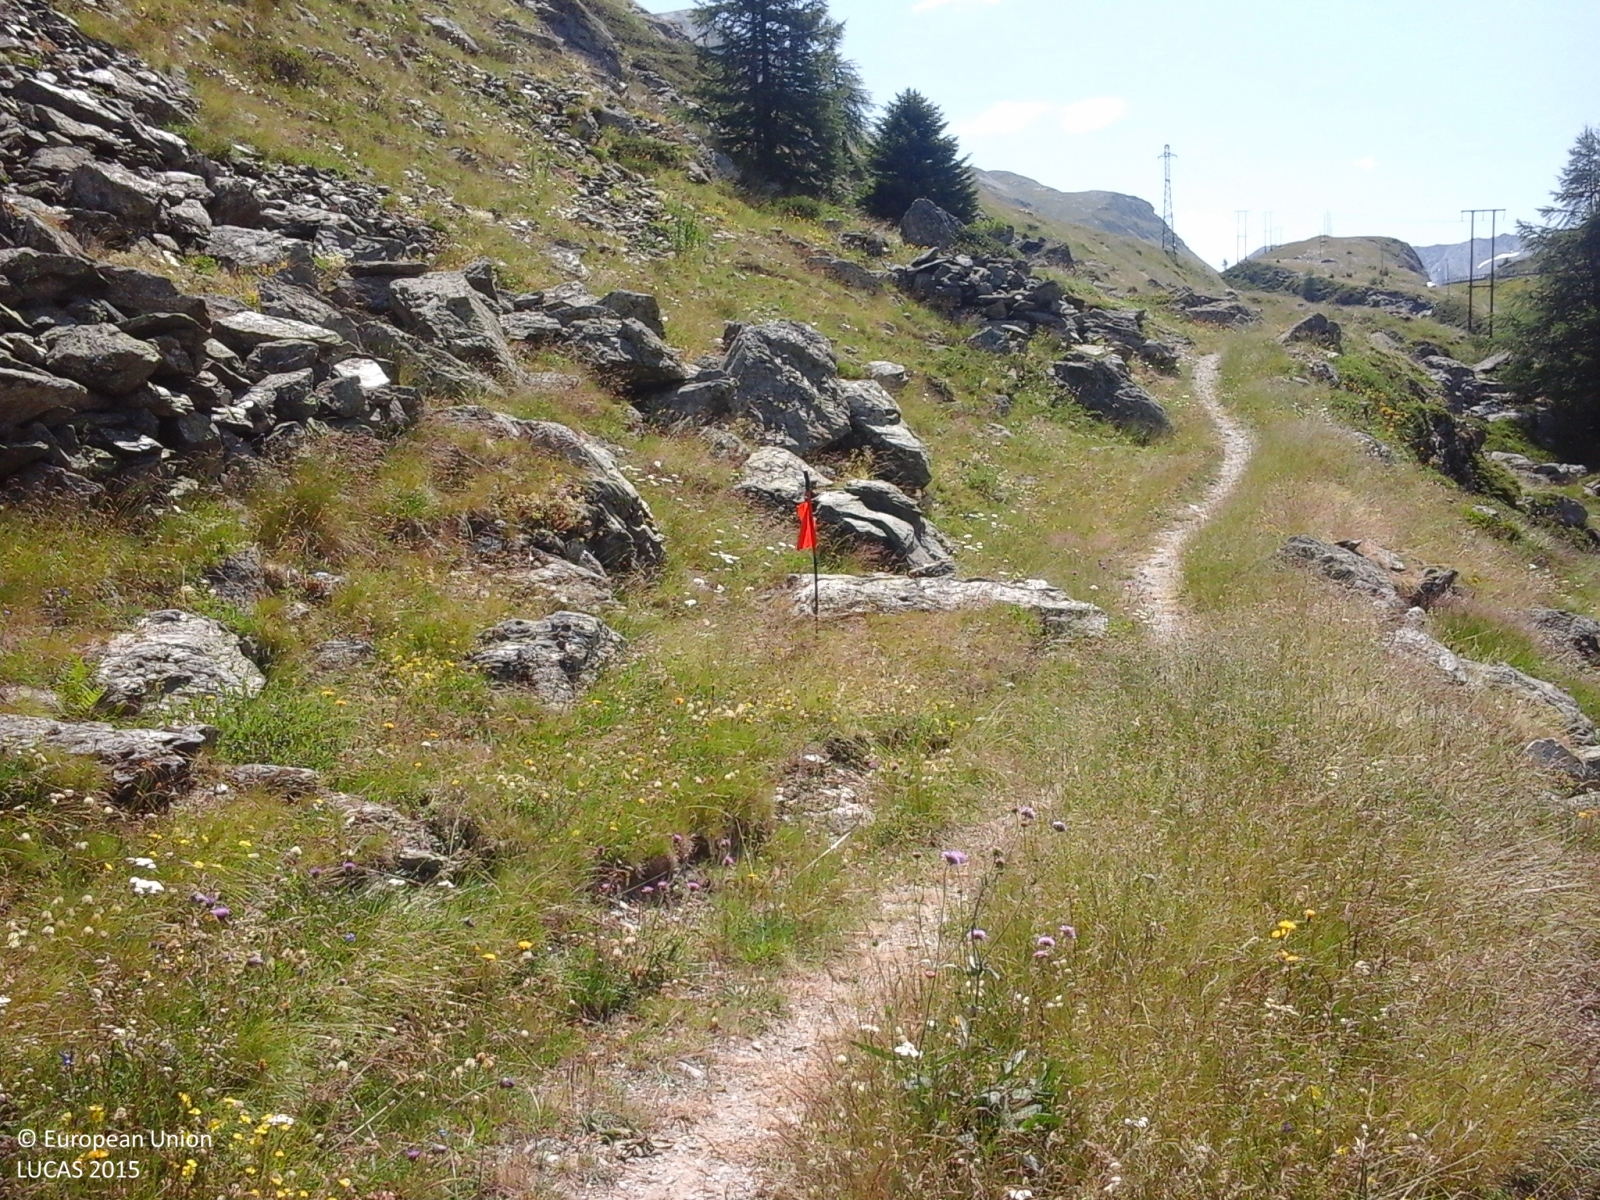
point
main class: Grassland
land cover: Grassland without tree/shrub cover
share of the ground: > 75 %
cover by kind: herbaceous plants 70 %, consolidated bare surface 30 %
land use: Agriculture (excluding fallow land and kitchen gardens)
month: July
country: IT
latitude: 46.5131
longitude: 10.1952
